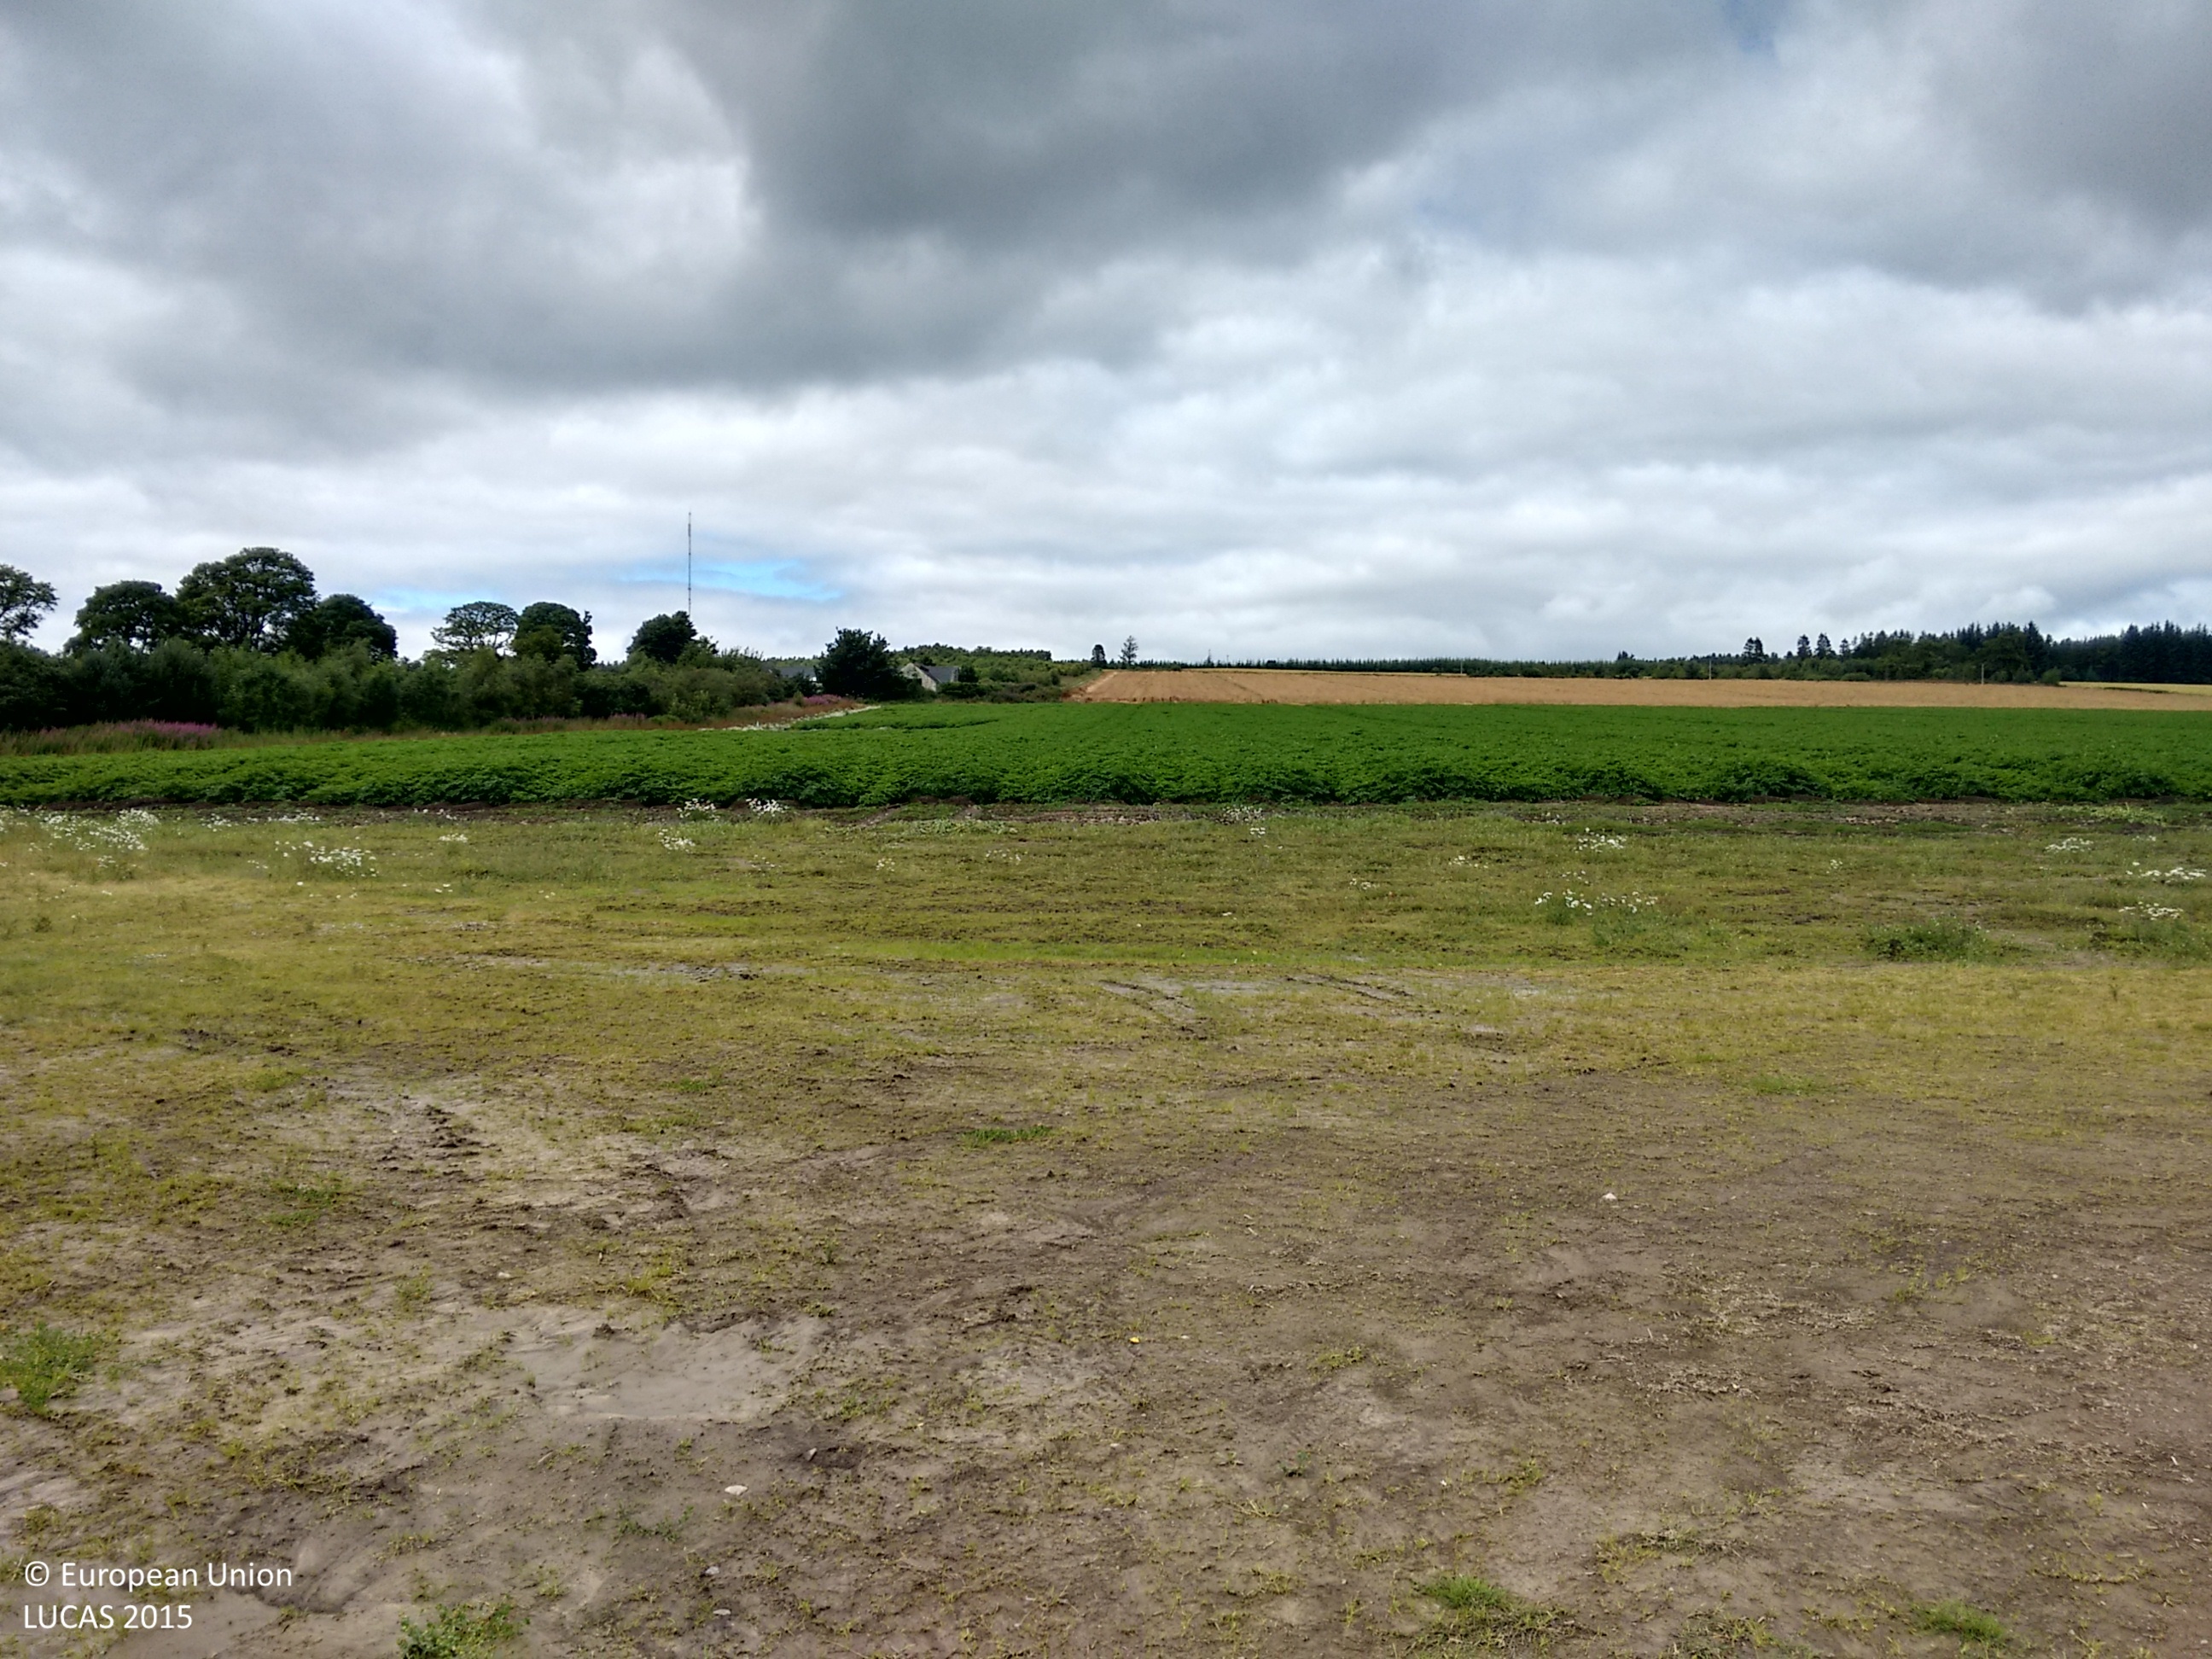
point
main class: Cropland
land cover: Potatoes
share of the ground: > 75 %
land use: Agriculture (excluding fallow land and kitchen gardens)
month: August
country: GB
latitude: 57.5827
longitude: -4.2513
